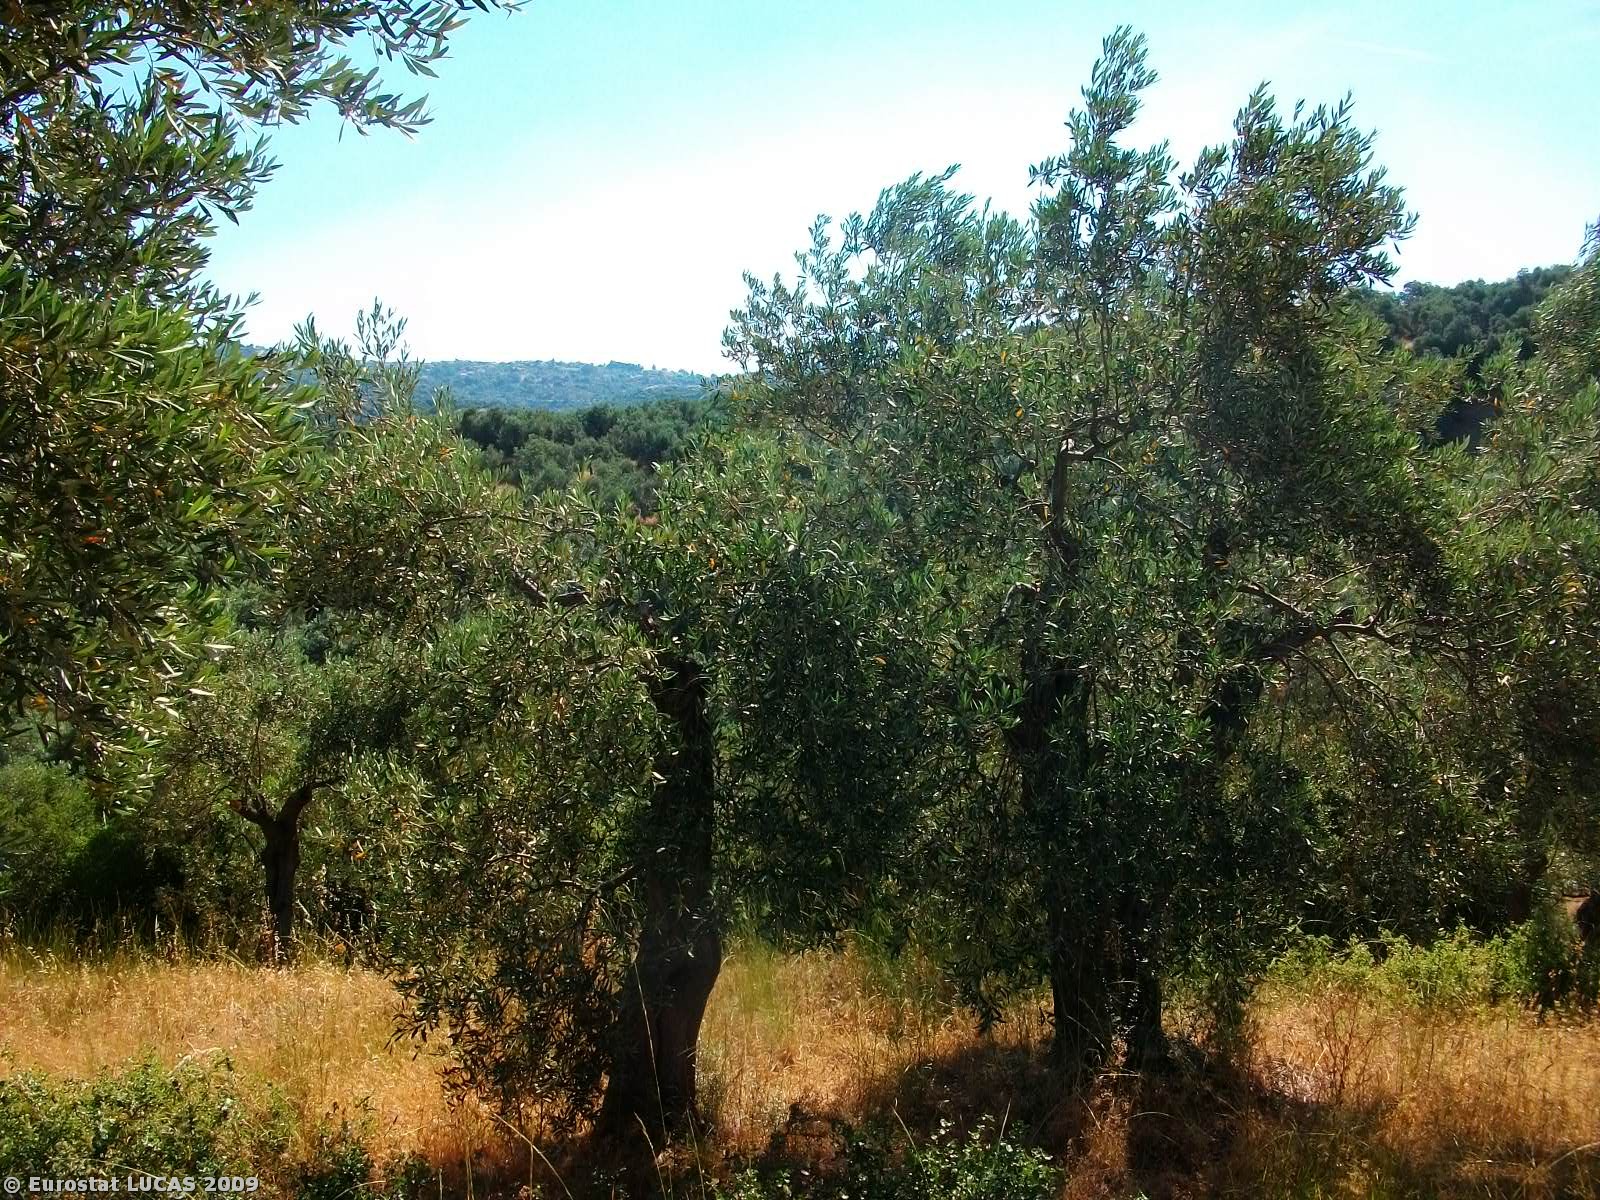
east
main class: Cropland
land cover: Olive groves
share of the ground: 50 - 75 %
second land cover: Grassland with sparse tree/shrub cover
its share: > 75 %
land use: Agriculture (excluding fallow land and kitchen gardens)
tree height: < 5 m
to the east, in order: Olive groves; Grassland with sparse tree/shrub cover; Tracks; Olive groves; Dry stone walls; Olive groves; Tracks; Shrubland with sparse tree cover
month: June
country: GR
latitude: 39.1669
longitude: 23.2208
